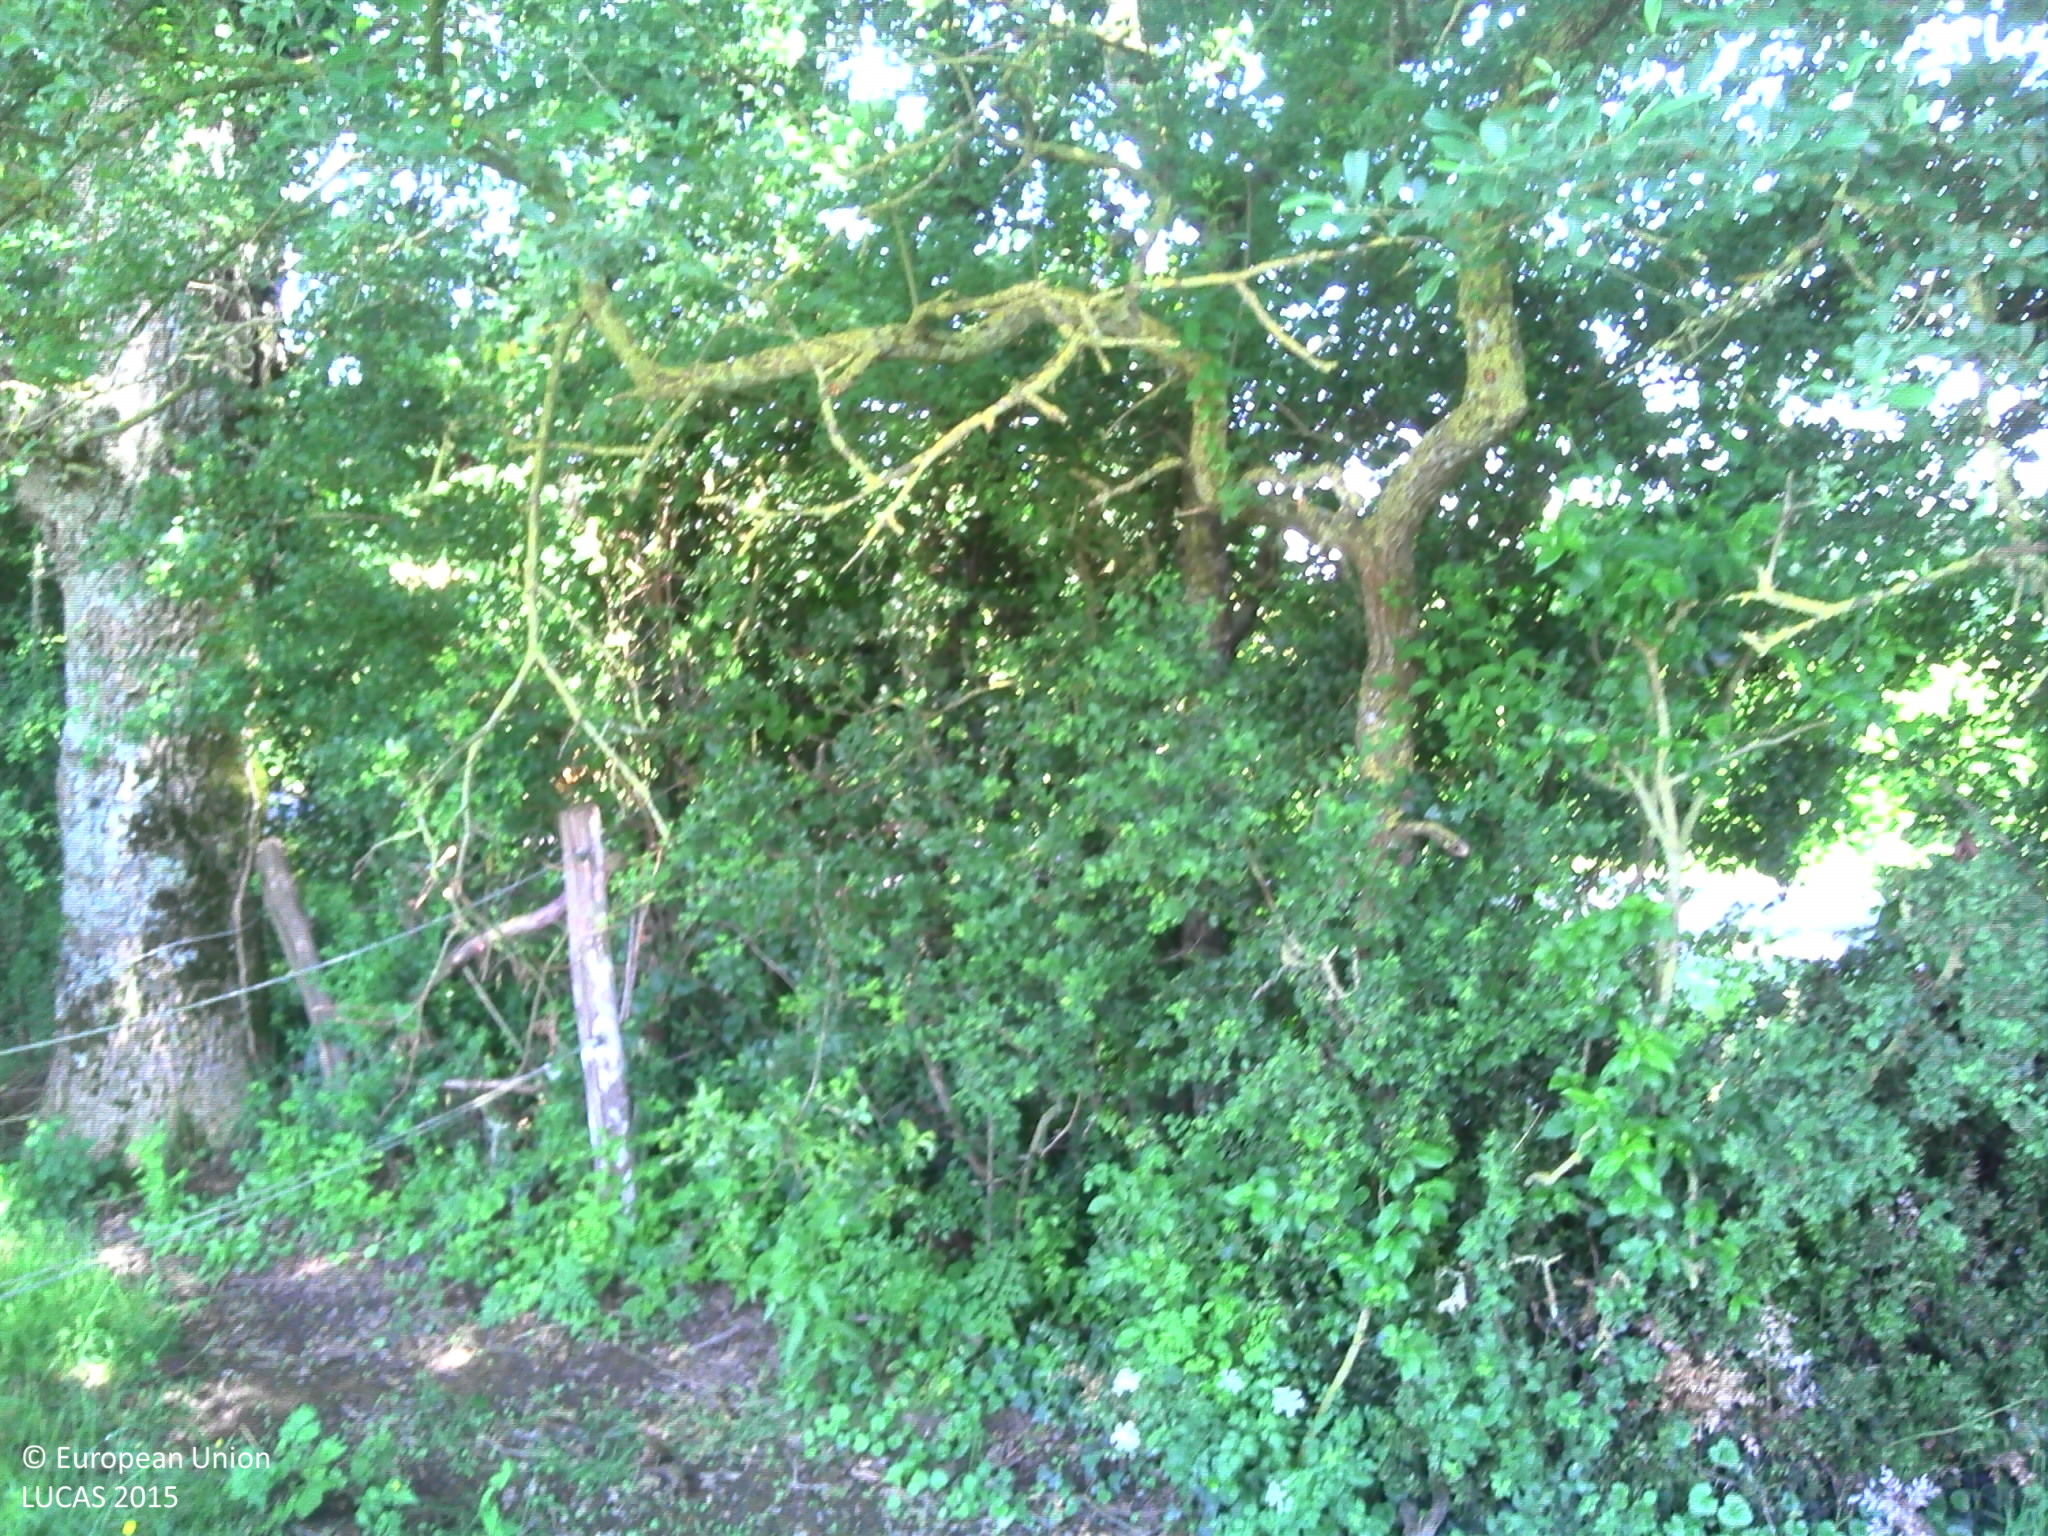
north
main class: Grassland
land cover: Grassland without tree/shrub cover
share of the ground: > 75 %
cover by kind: herbaceous plants 100 %
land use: Sport
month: June
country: FR
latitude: 46.8177
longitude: -1.3486
